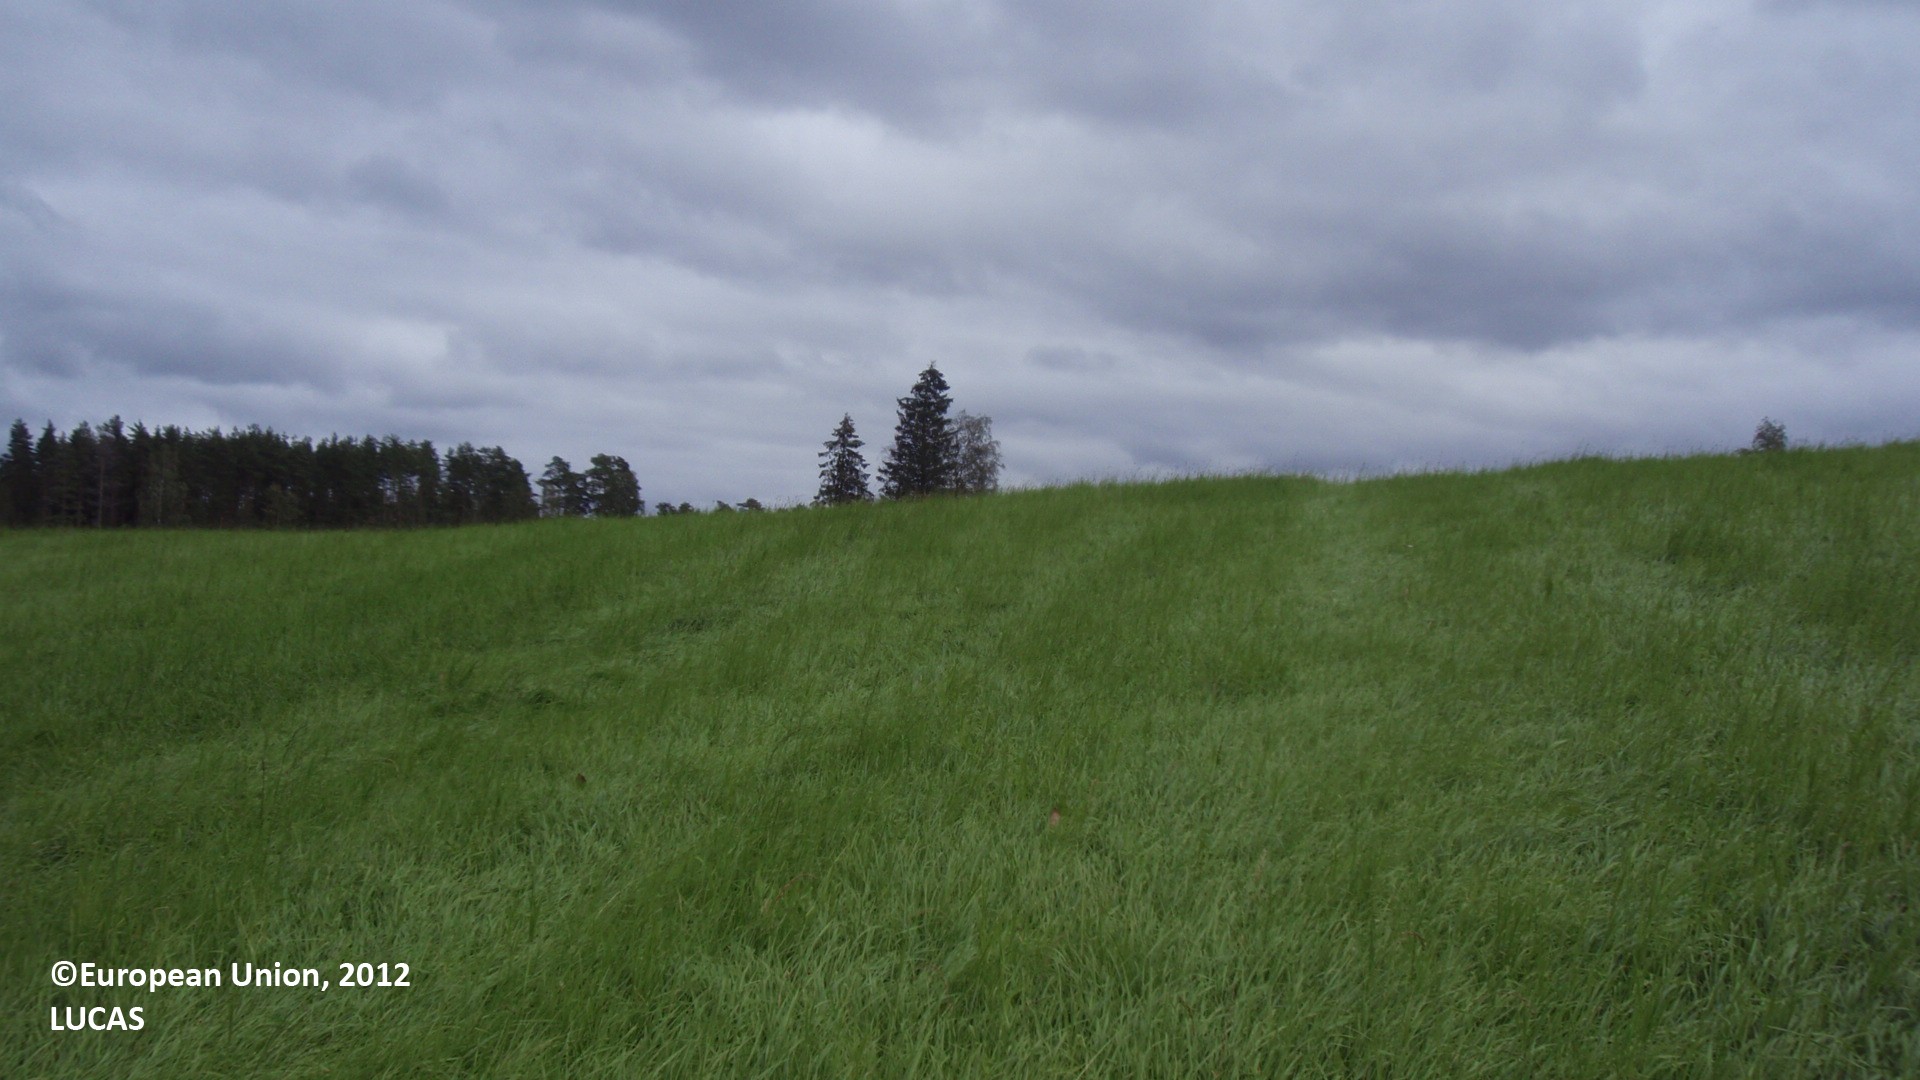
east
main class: Cropland
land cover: Mixed cereals for fodder
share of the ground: > 75 %
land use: Agriculture (excluding fallow land and kitchen gardens)
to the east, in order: Mixed cereals for fodder; Spruce dominated coniferous woodland; Mixed cereals for fodder
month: August
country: FI
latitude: 61.1108
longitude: 27.6467
